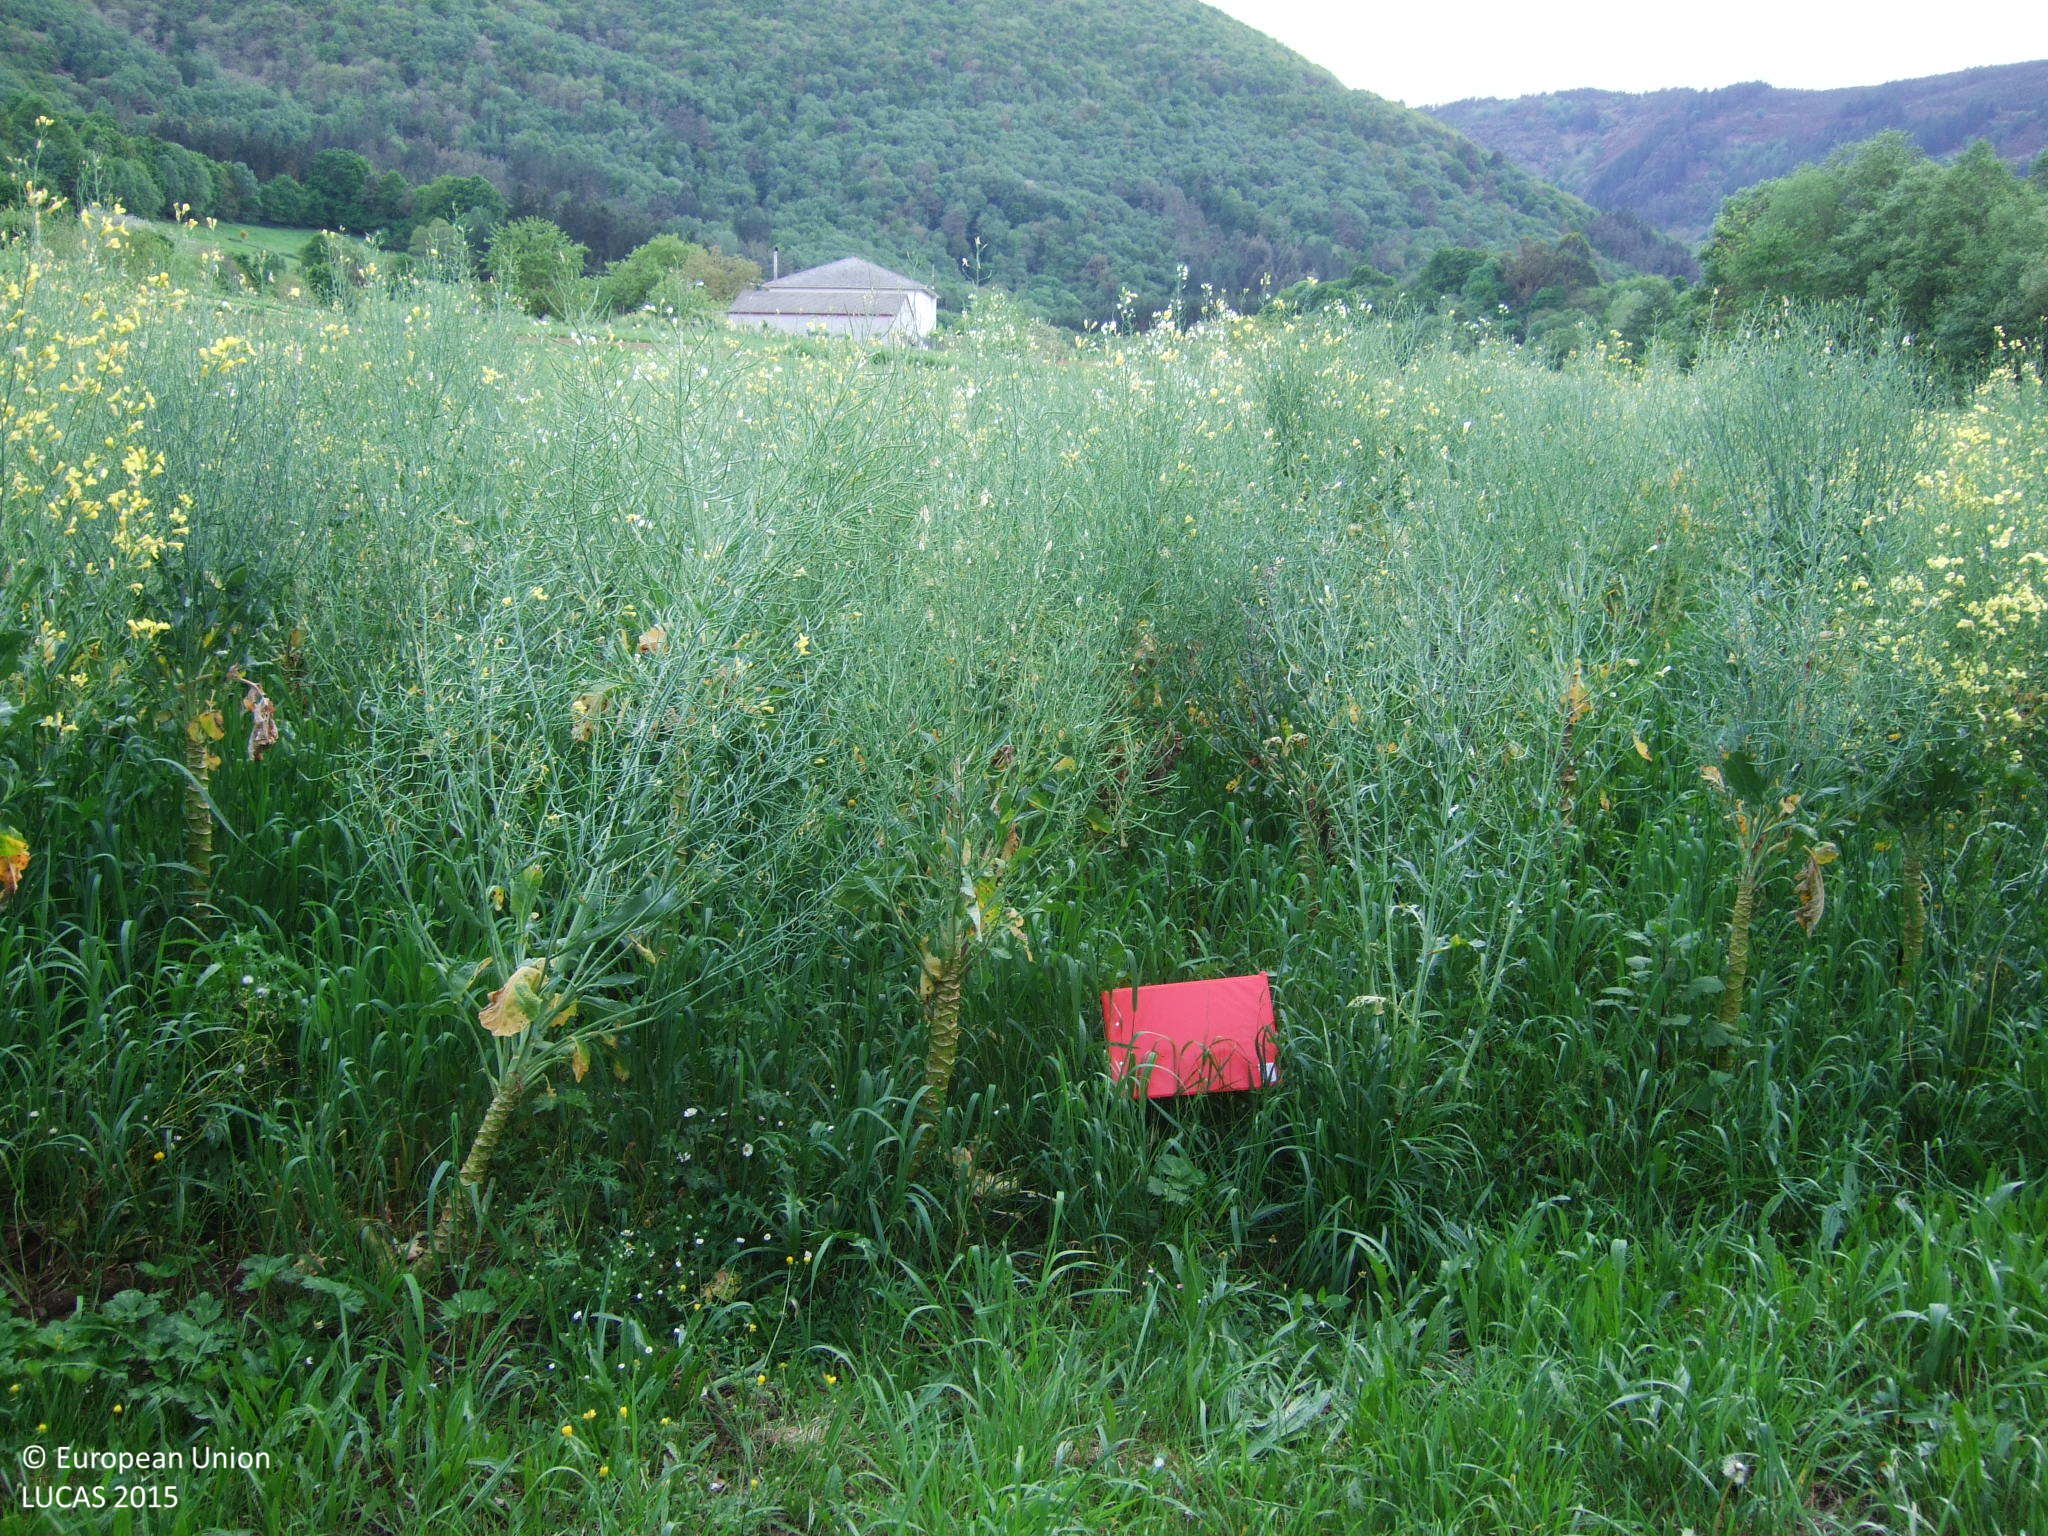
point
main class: Cropland
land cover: Other fresh vegetables
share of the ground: 50 - 75 %
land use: Agriculture (excluding fallow land and kitchen gardens)
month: May
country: ES
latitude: 43.1587
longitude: -7.2010
